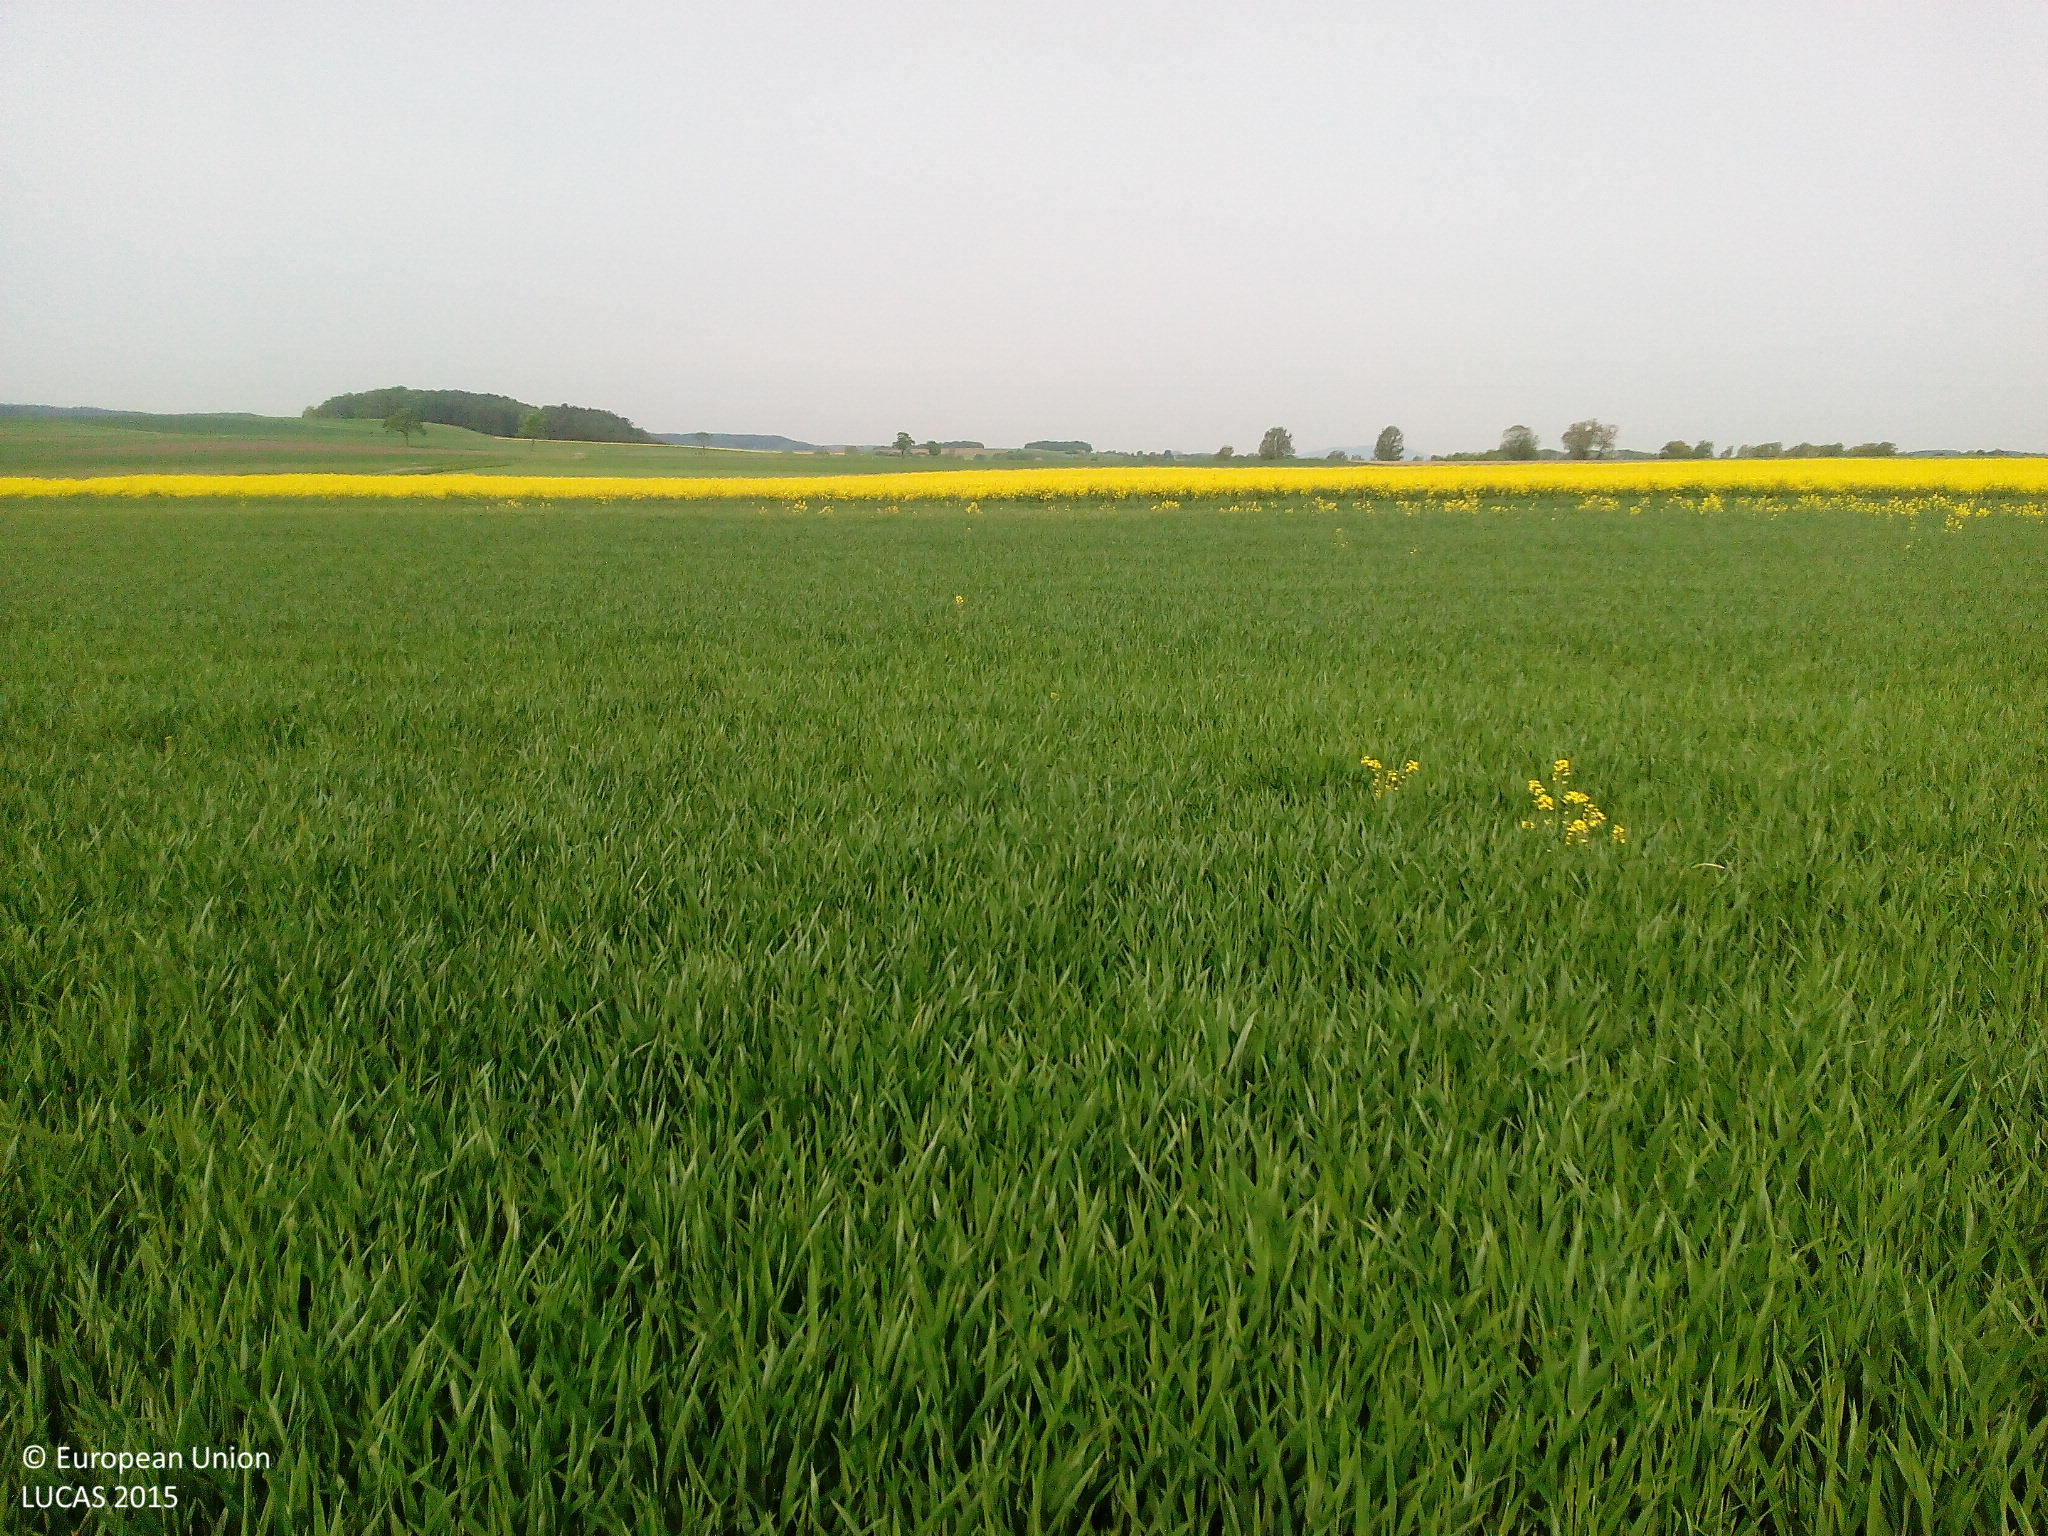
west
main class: Cropland
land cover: Oats
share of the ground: > 75 %
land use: Agriculture (excluding fallow land and kitchen gardens)
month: May
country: DE
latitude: 50.3062
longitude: 10.9405
